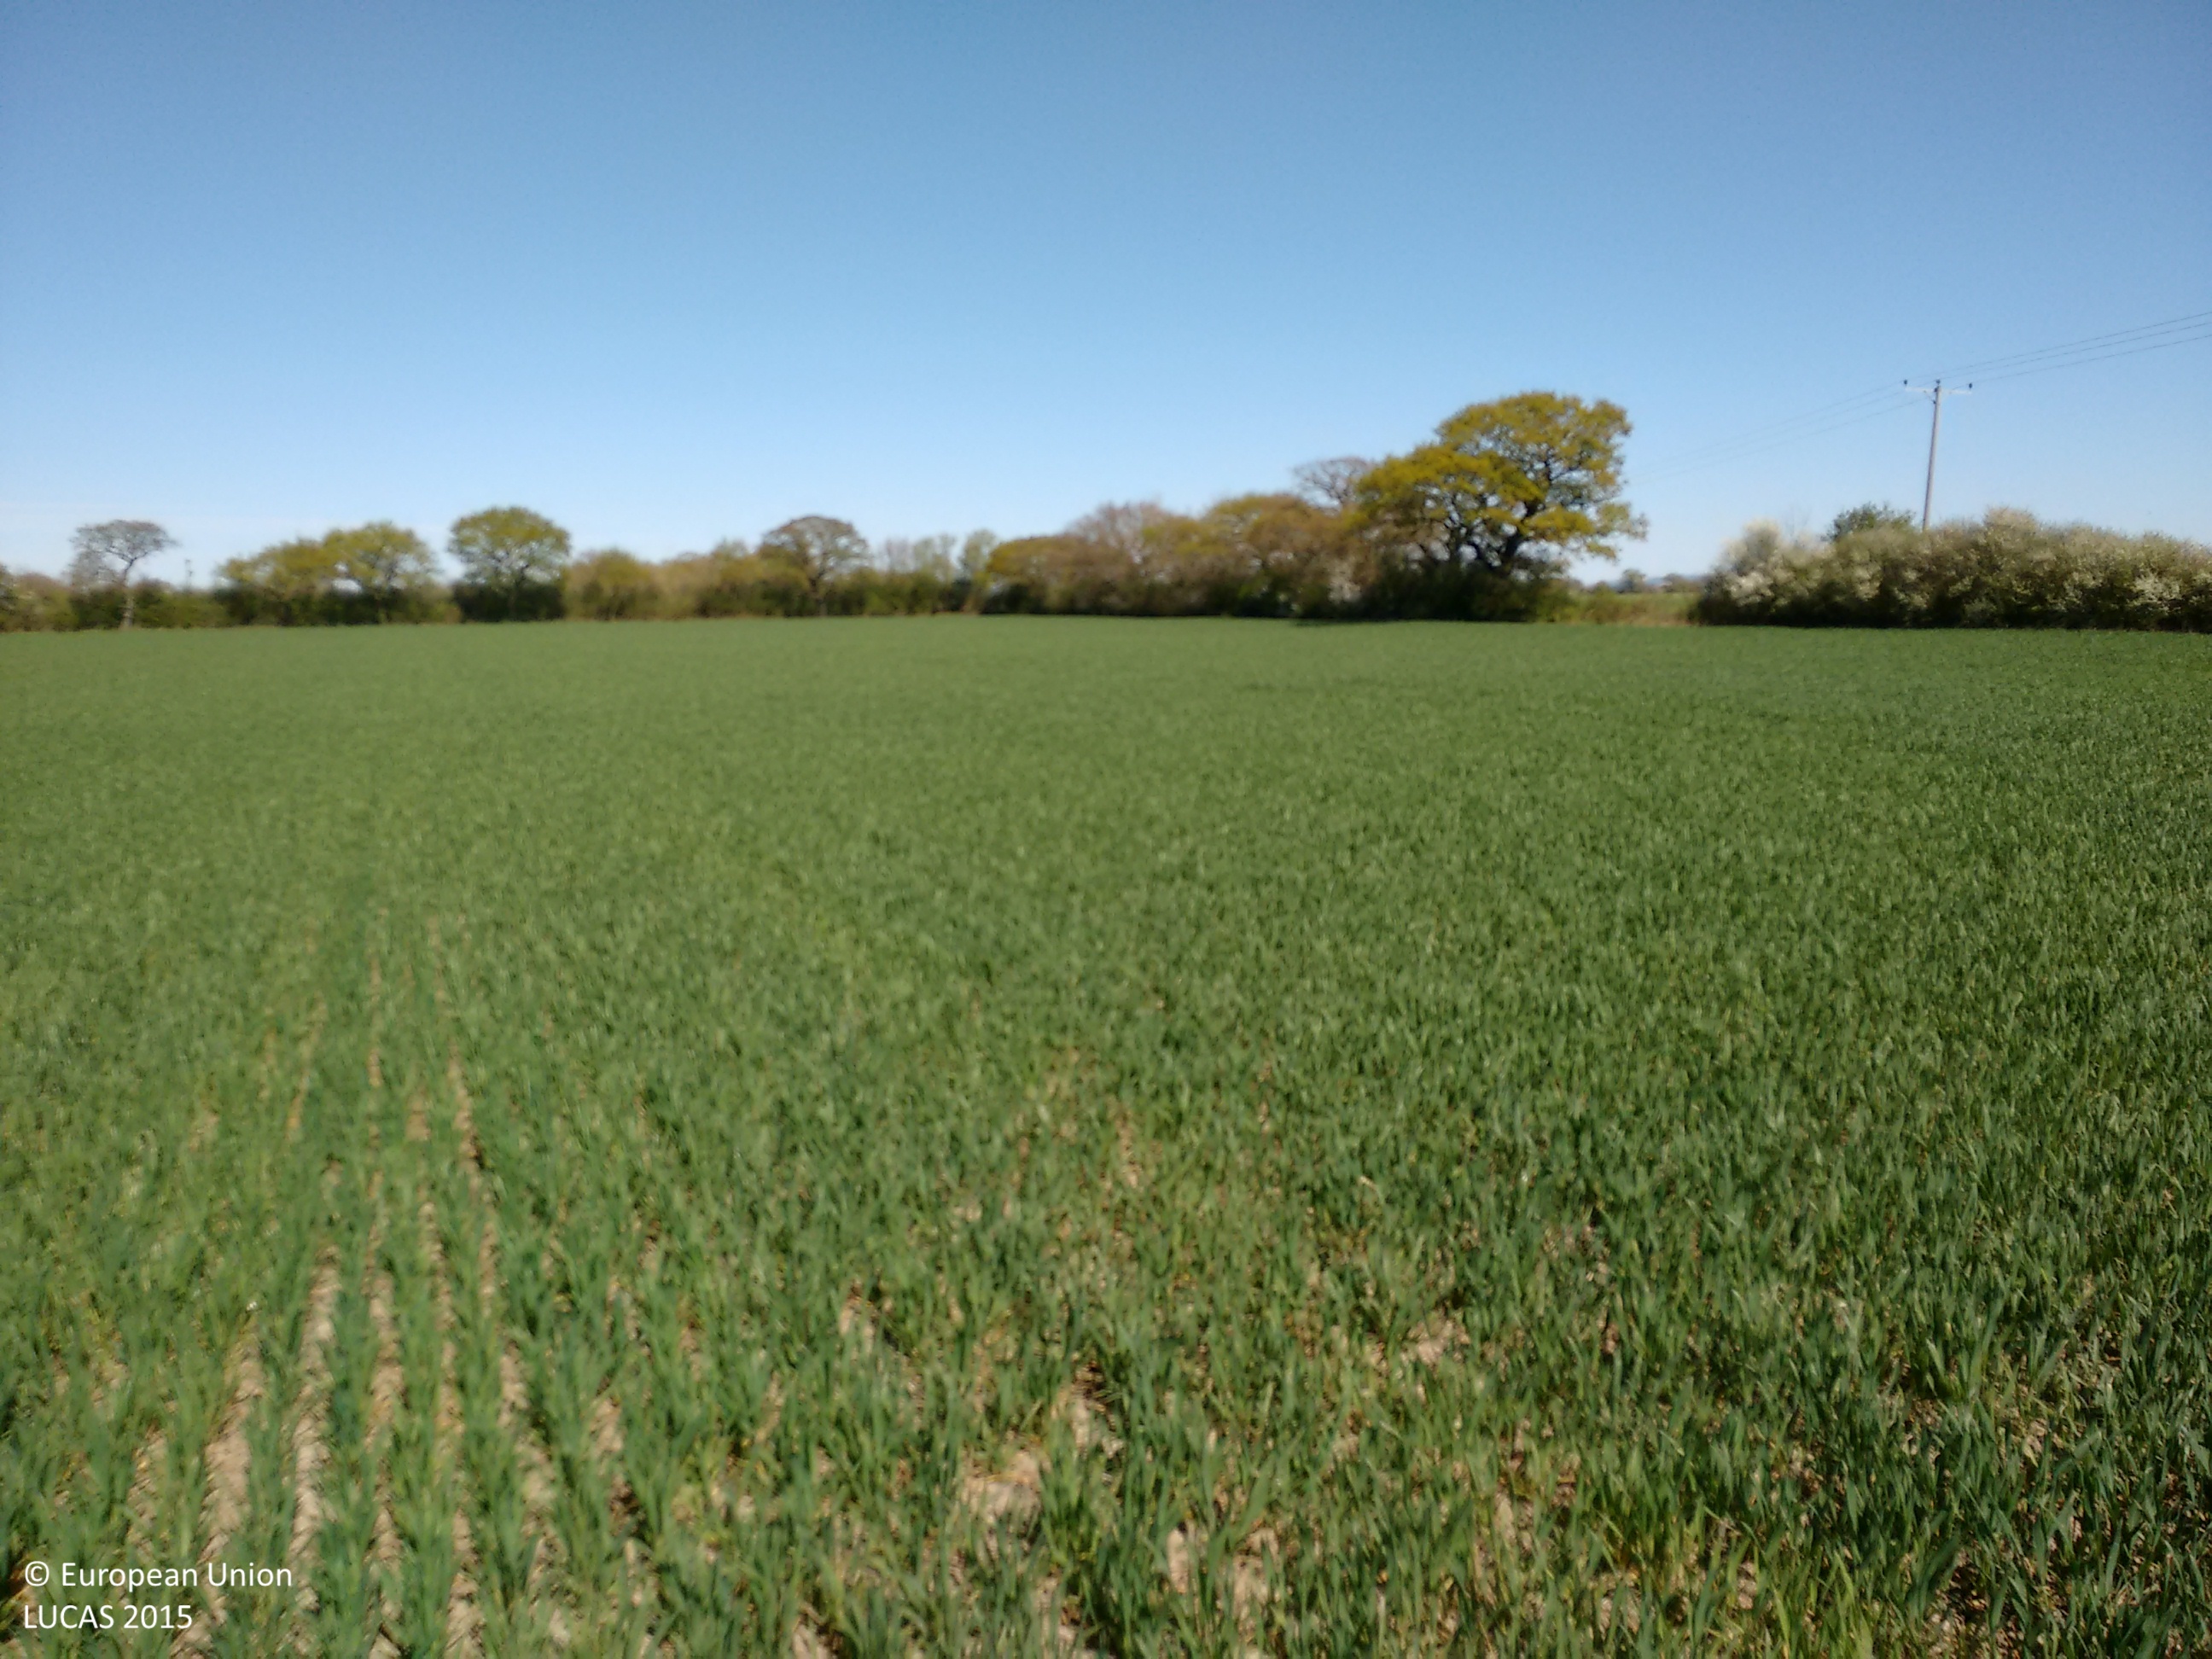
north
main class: Cropland
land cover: Common wheat
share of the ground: > 75 %
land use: Agriculture (excluding fallow land and kitchen gardens)
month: April
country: GB
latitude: 53.7855
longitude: -0.8322
